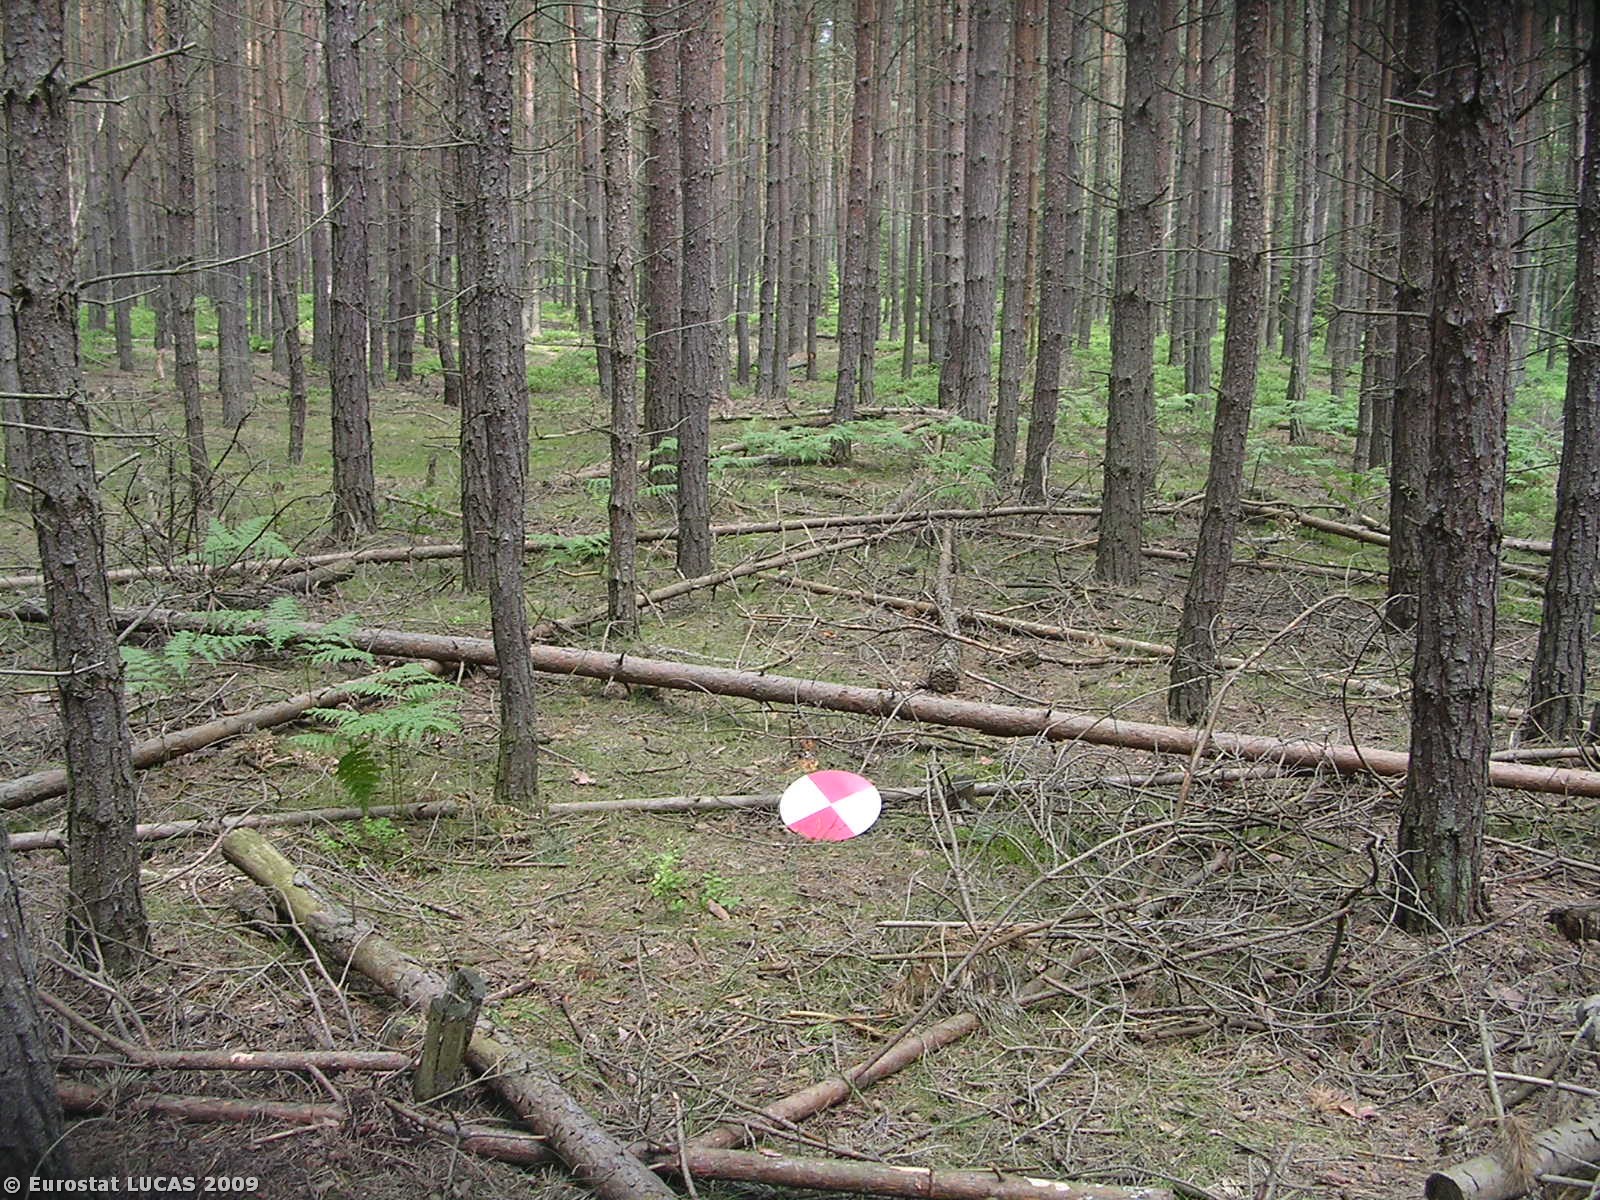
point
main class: Woodland
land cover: Coniferous woodland
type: hemiboreal forest and nemoral coniferous forest and mixed broadleaved-coniferous forest
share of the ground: > 75 %
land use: Forestry
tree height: > 5 m
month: June
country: CZ
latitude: 50.5544
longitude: 14.7307
